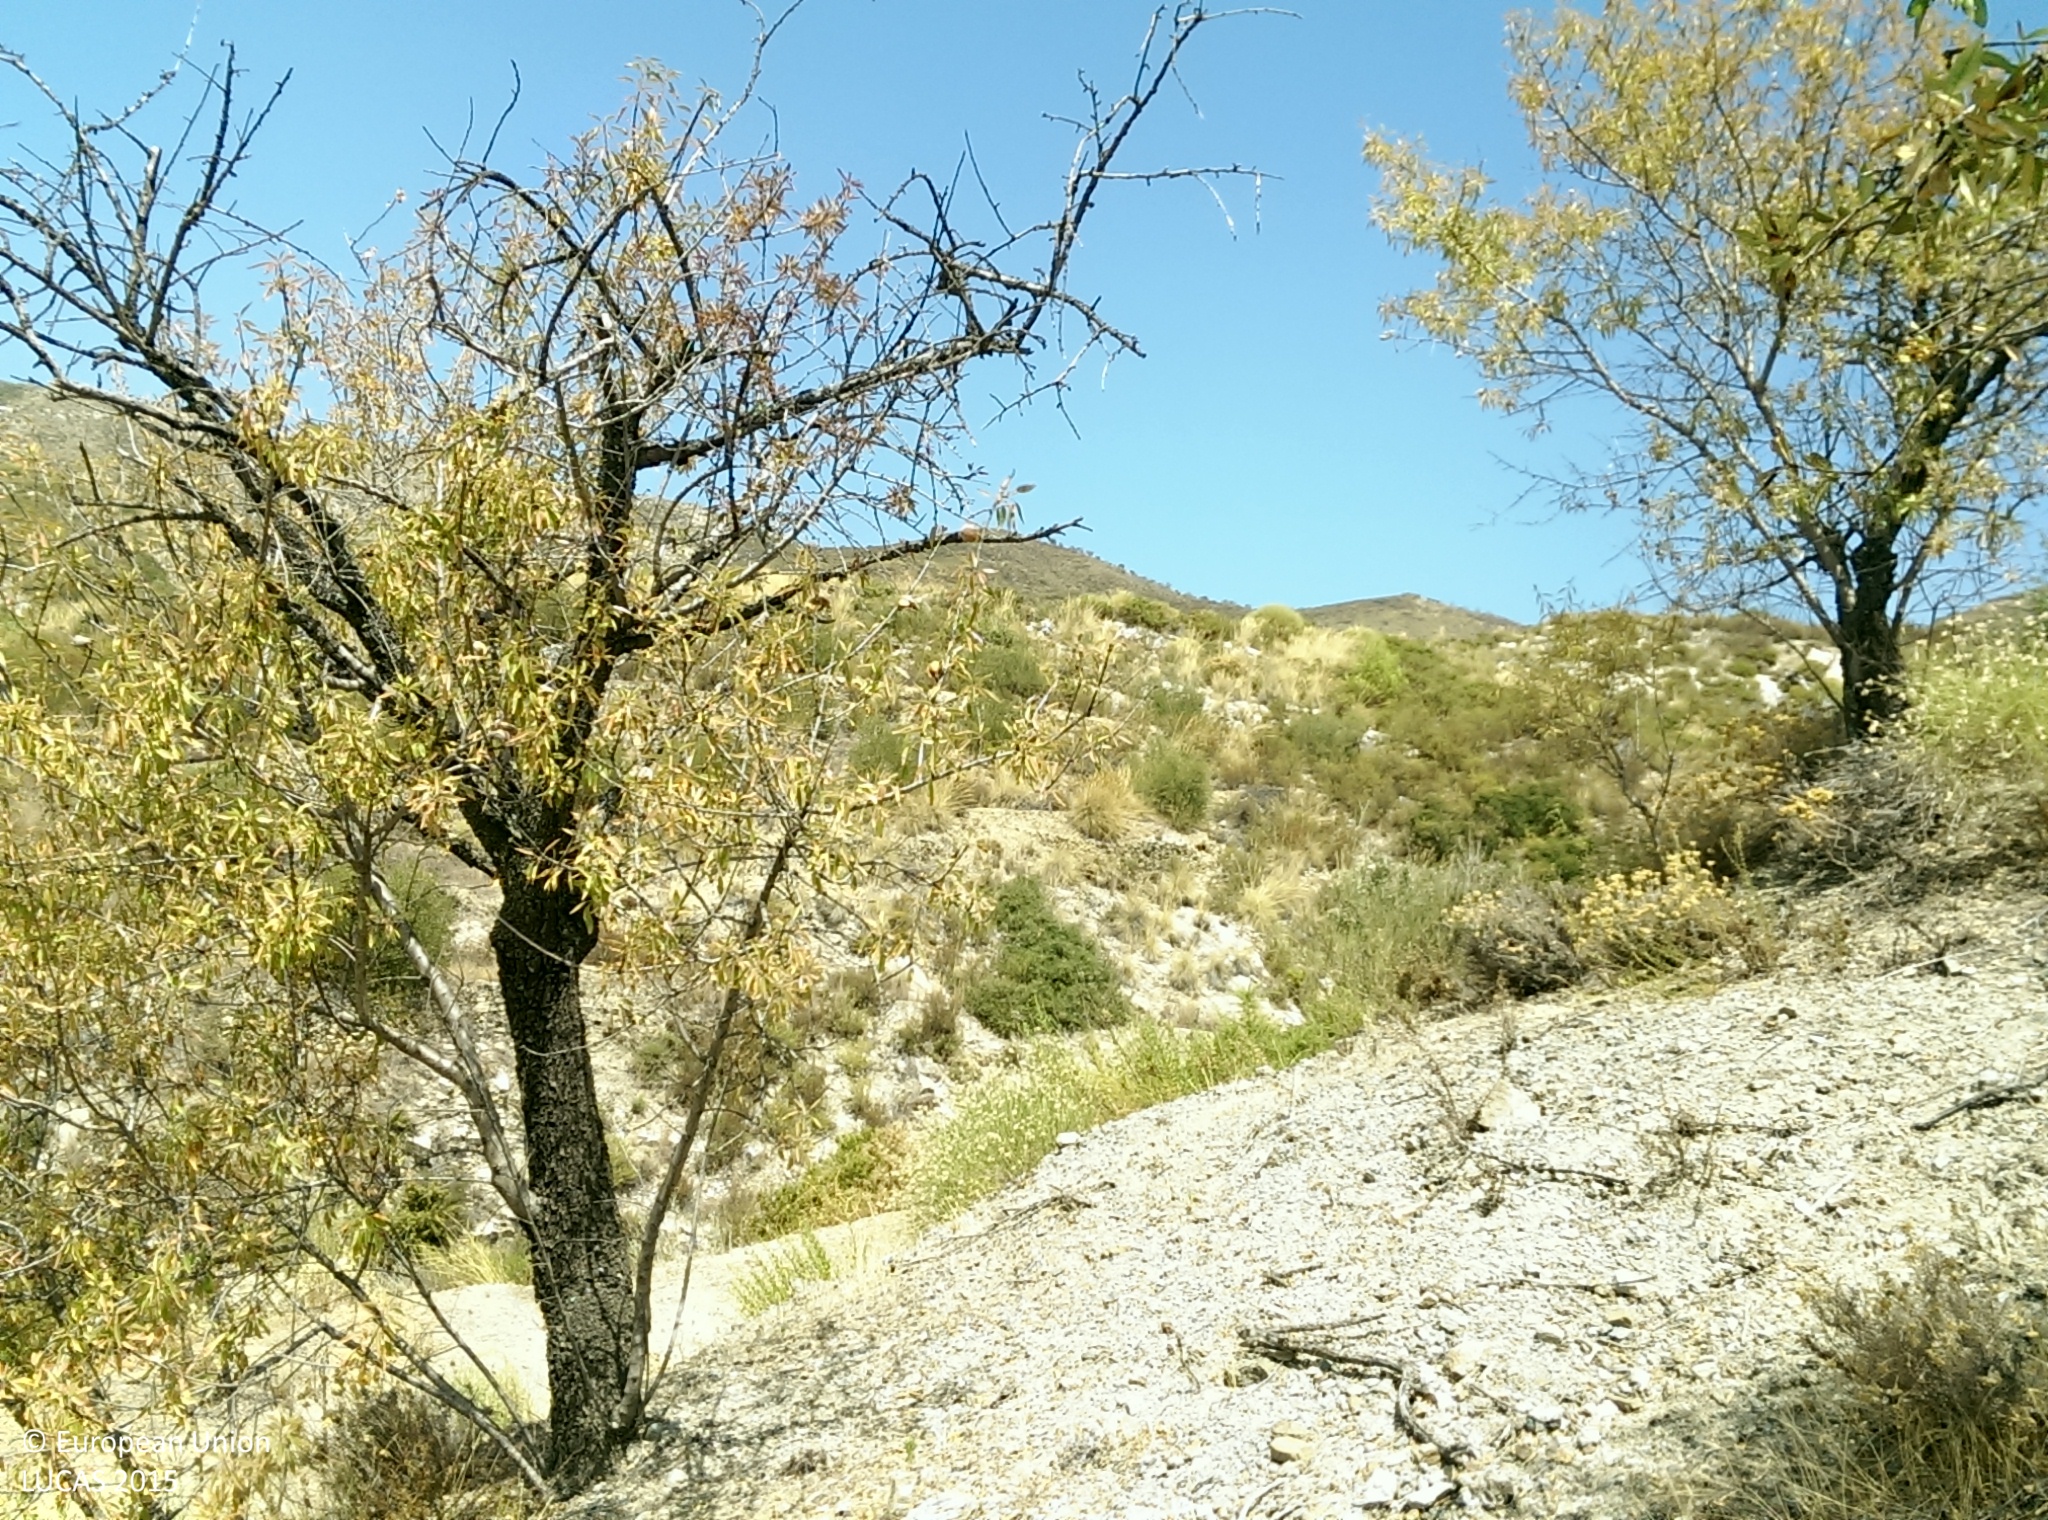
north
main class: Shrubland
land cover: Shrubland without tree cover
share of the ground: > 75 %
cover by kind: shrubs 100 %
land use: Abandoned areas
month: August
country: ES
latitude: 36.8168
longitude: -3.6263
